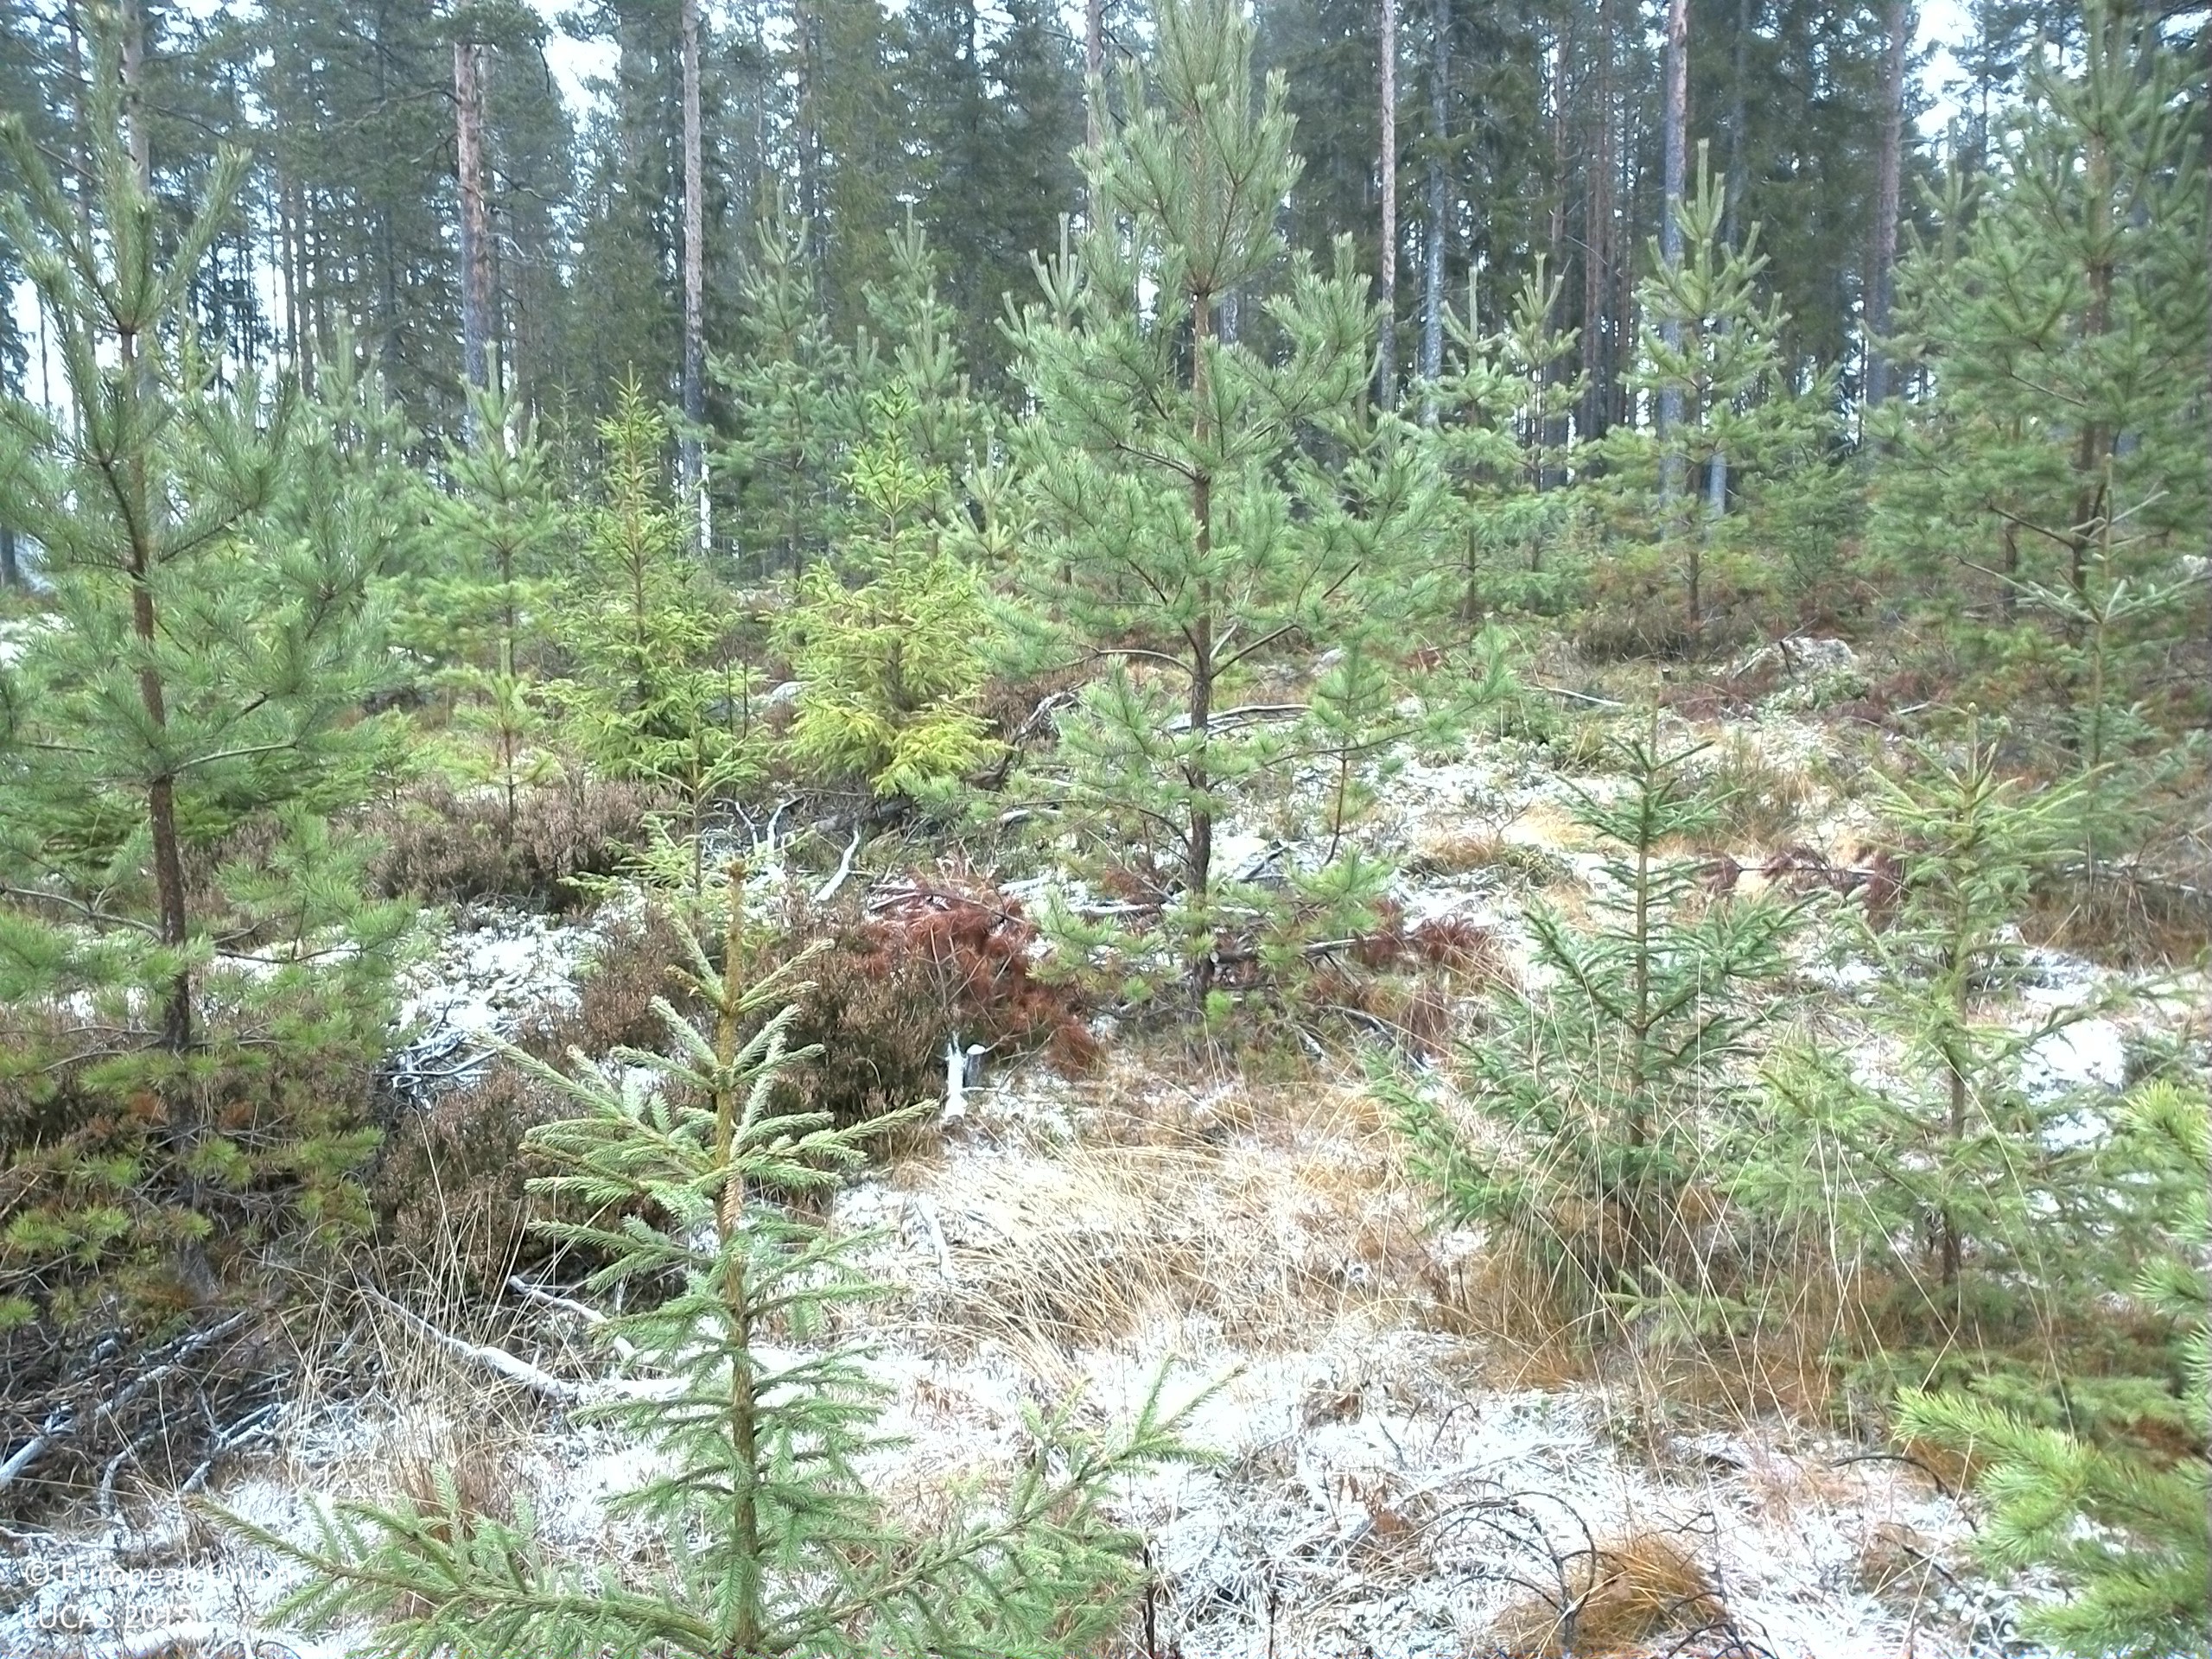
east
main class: Woodland
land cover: Other coniferous woodland
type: boreal forest
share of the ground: 50 - 75 %
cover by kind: coniferous forest trees 65 %, shrubs 15 %, herbaceous plants 10 %, broadleaved forest trees 5 %, consolidated bare surface 5 %
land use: Forestry
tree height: < 5 m
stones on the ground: < 10 %
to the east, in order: Other coniferous woodland; Pine dominated coniferous woodland; Shrubland with sparse tree cover; Other coniferous woodland; Shrubland with sparse tree cover
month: November
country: SE
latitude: 60.2959
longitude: 16.6293
